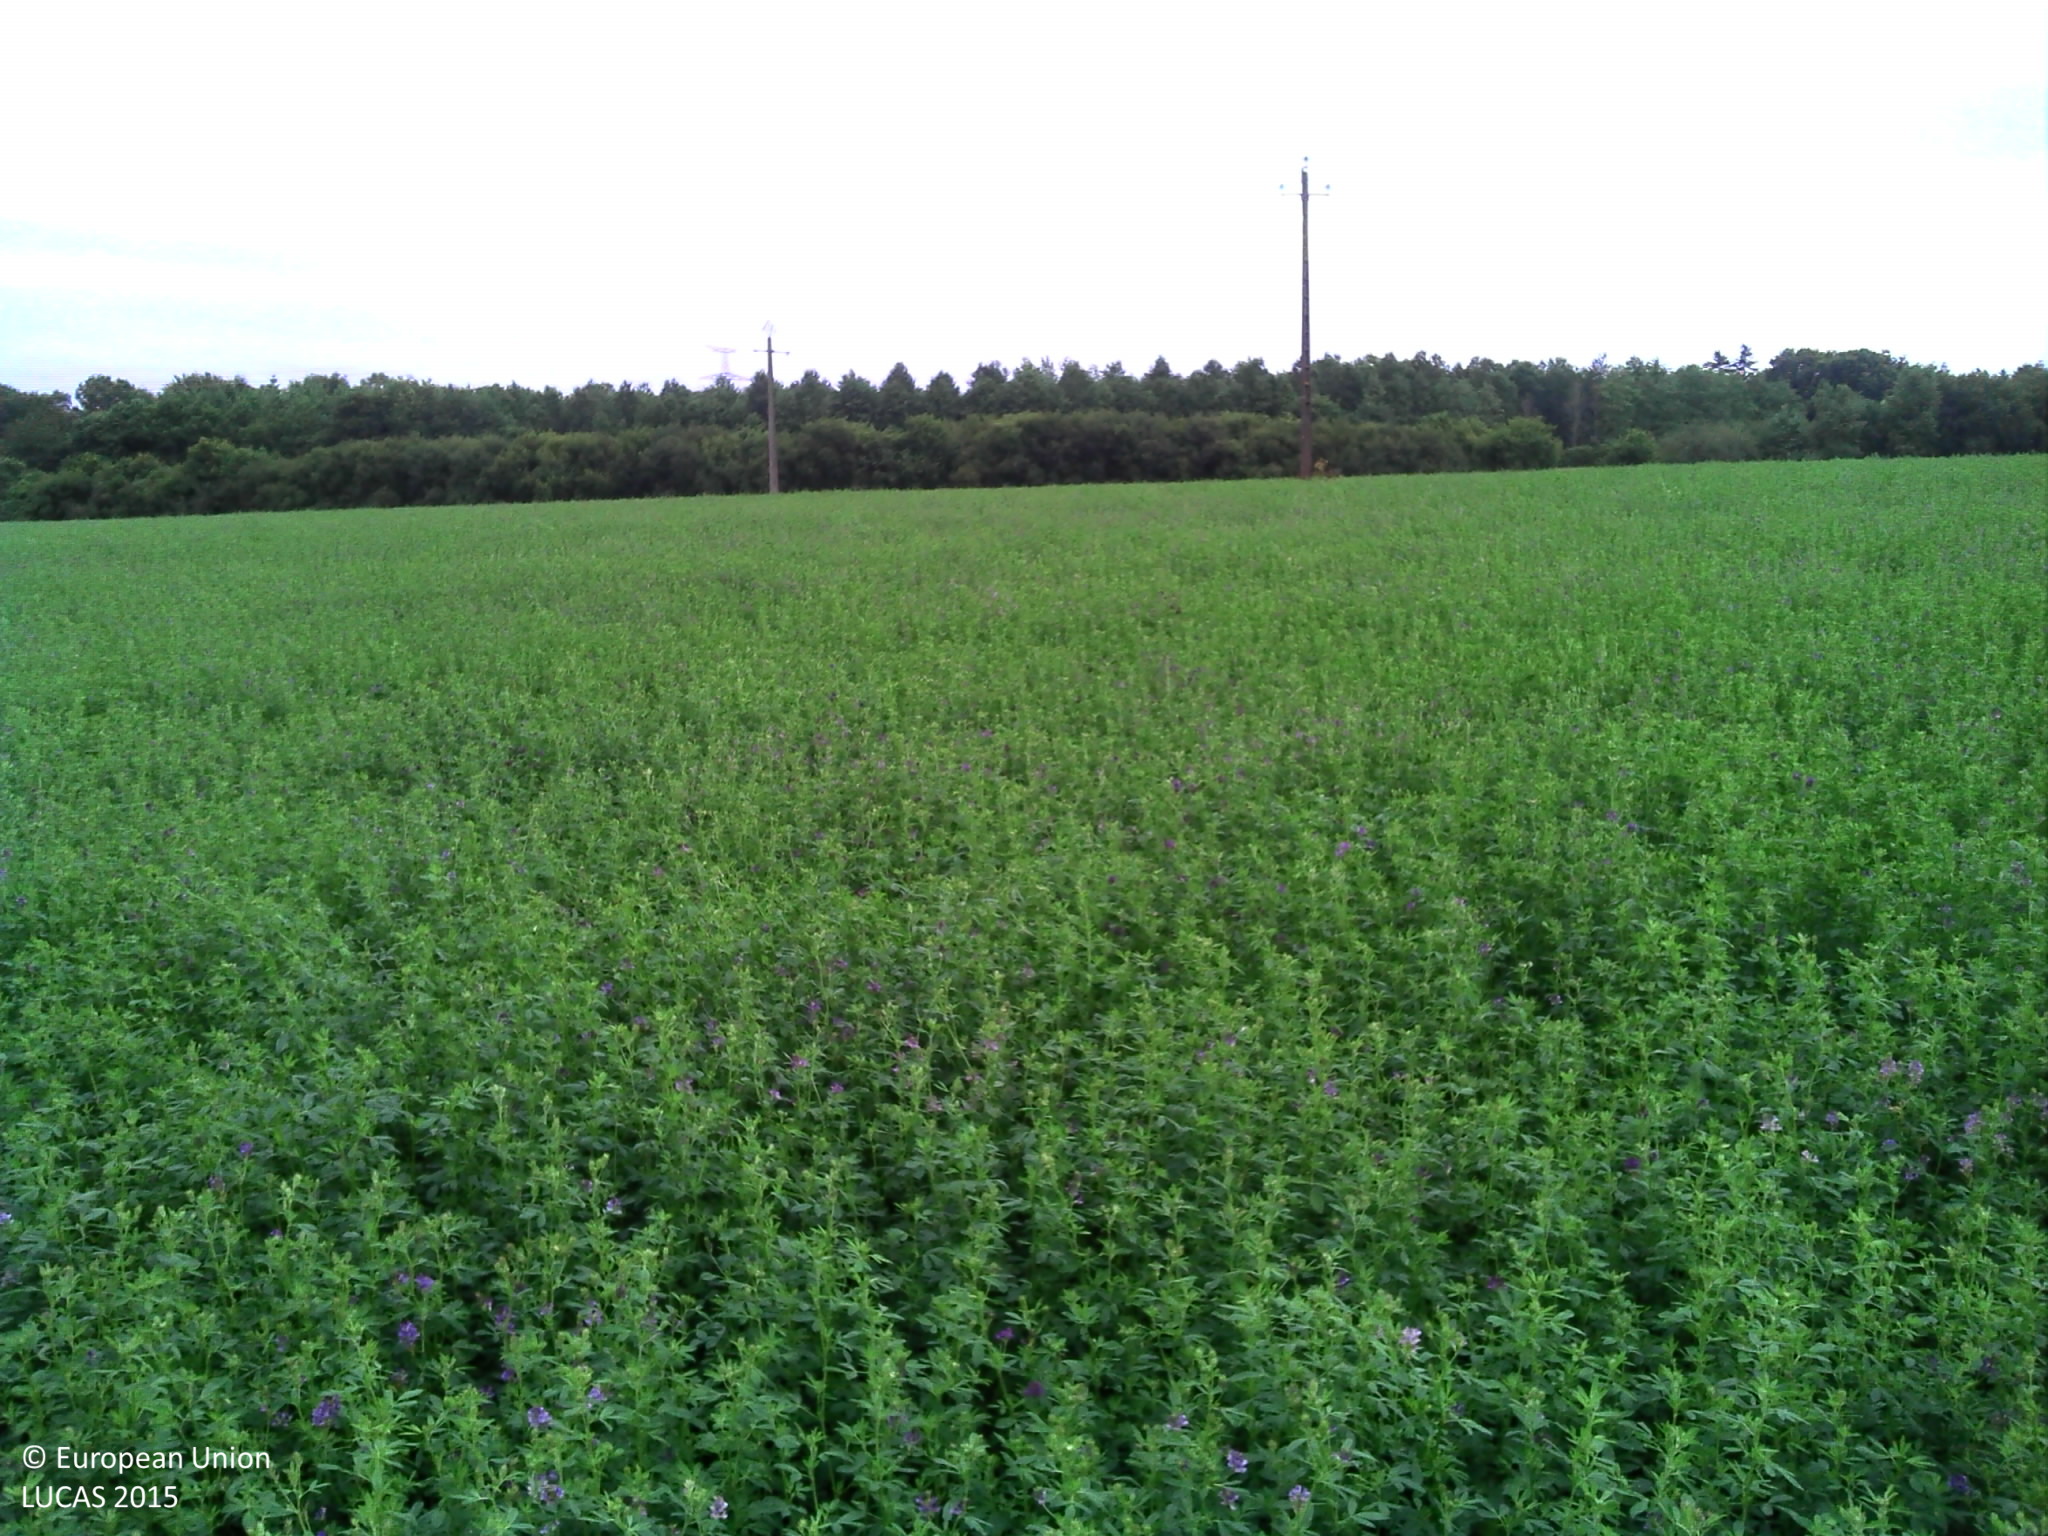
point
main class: Cropland
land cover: Lucerne
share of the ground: > 75 %
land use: Agriculture (excluding fallow land and kitchen gardens)
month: July
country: FR
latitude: 47.8134
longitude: -3.0075
